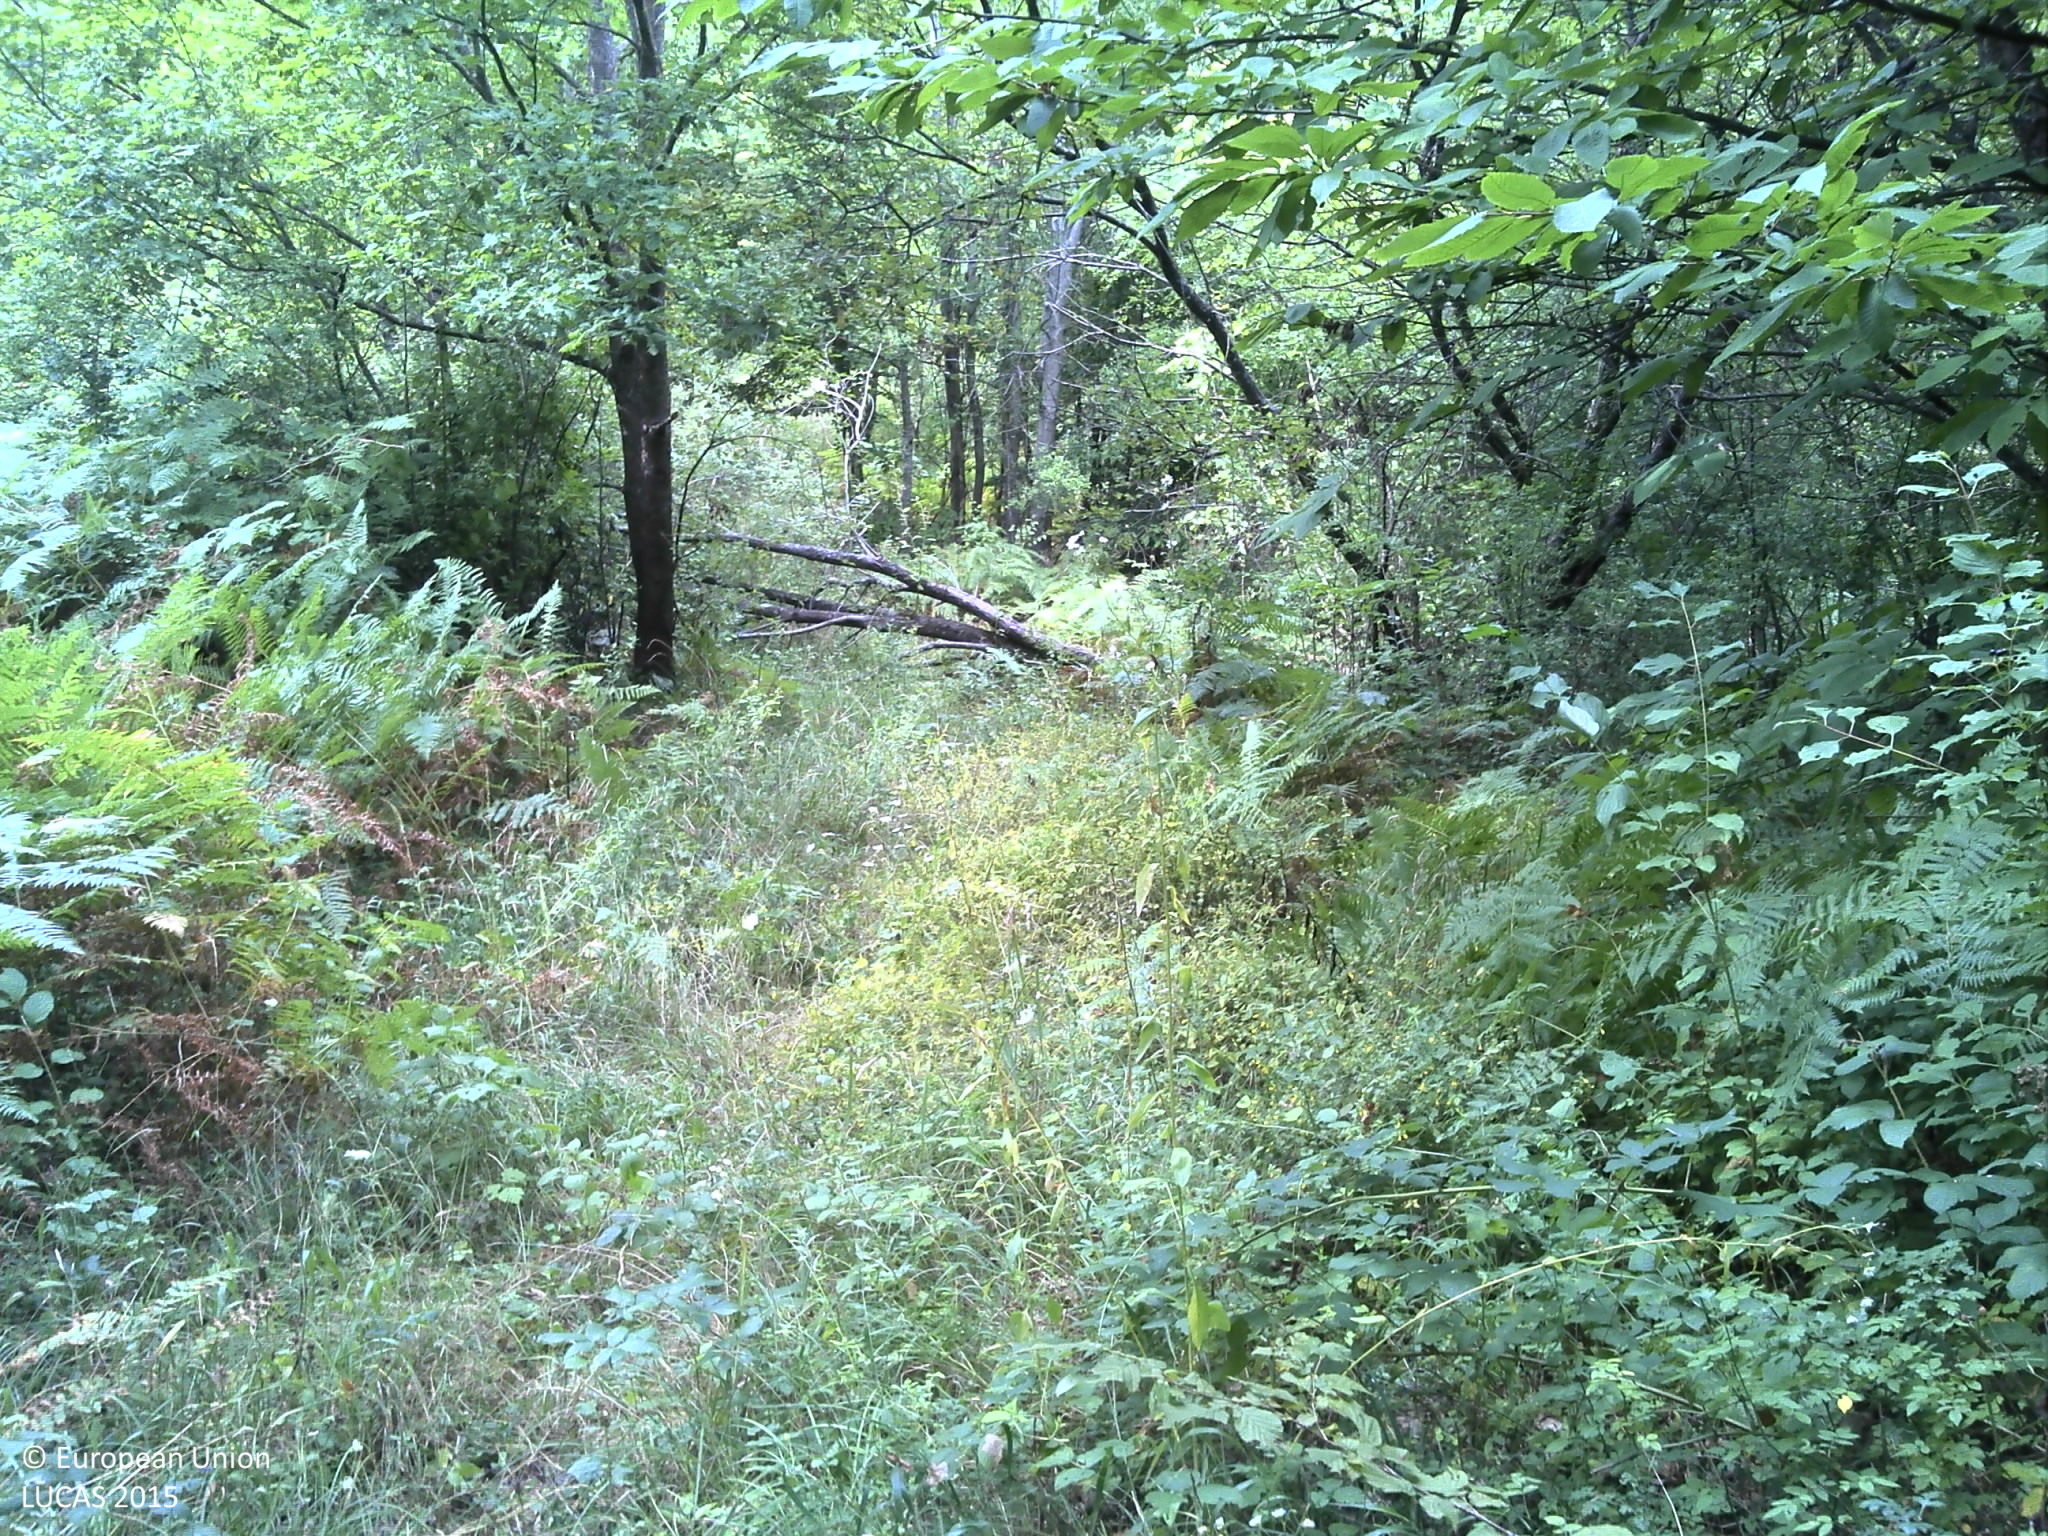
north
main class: Woodland
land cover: Broadleaved woodland
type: beech forest
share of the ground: > 75 %
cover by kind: broadleaved forest trees 100 %
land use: Forestry
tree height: > 5 m
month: August
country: HR
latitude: 45.2722
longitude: 16.1276
